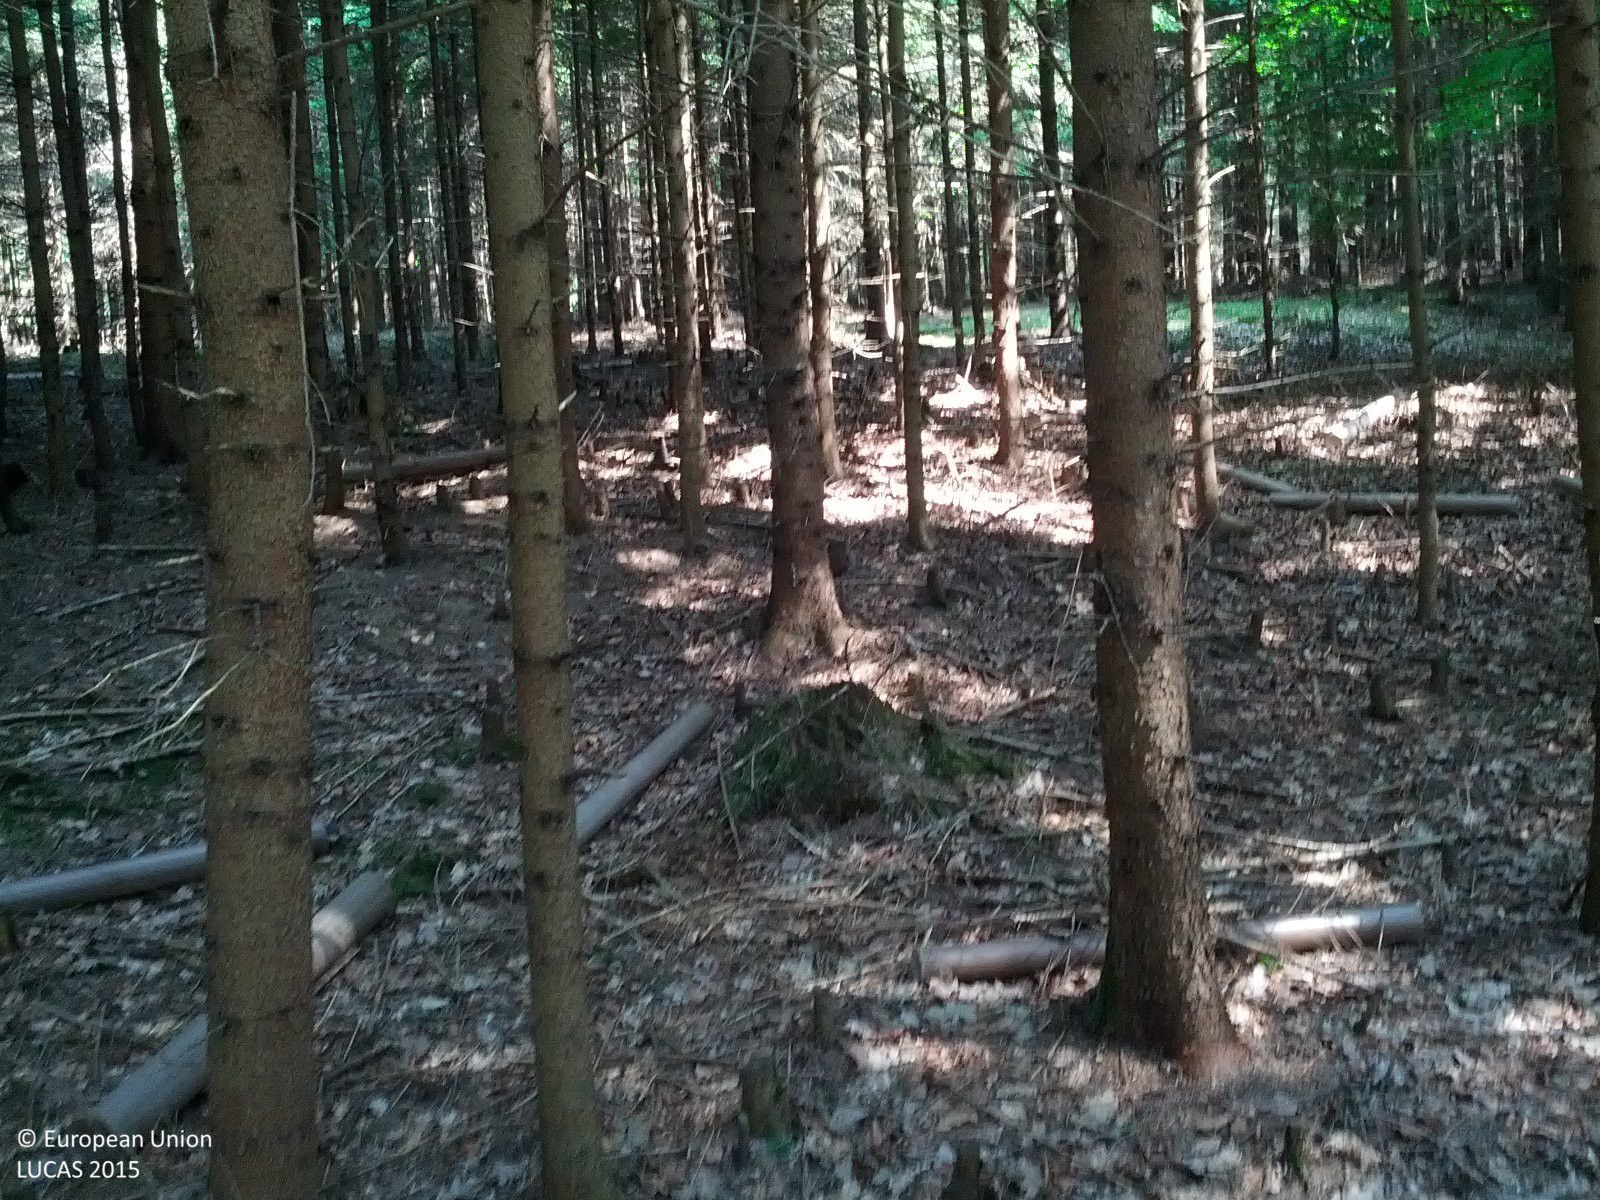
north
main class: Woodland
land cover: Spruce dominated coniferous woodland
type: hemiboreal forest and nemoral coniferous forest and mixed broadleaved-coniferous forest
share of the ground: > 75 %
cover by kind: coniferous forest trees 90 %, herbaceous plants 5 %, unconsolidated bare surface 5 %
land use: Forestry
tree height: > 5 m
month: July
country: AT
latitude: 47.2593
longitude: 16.1206
